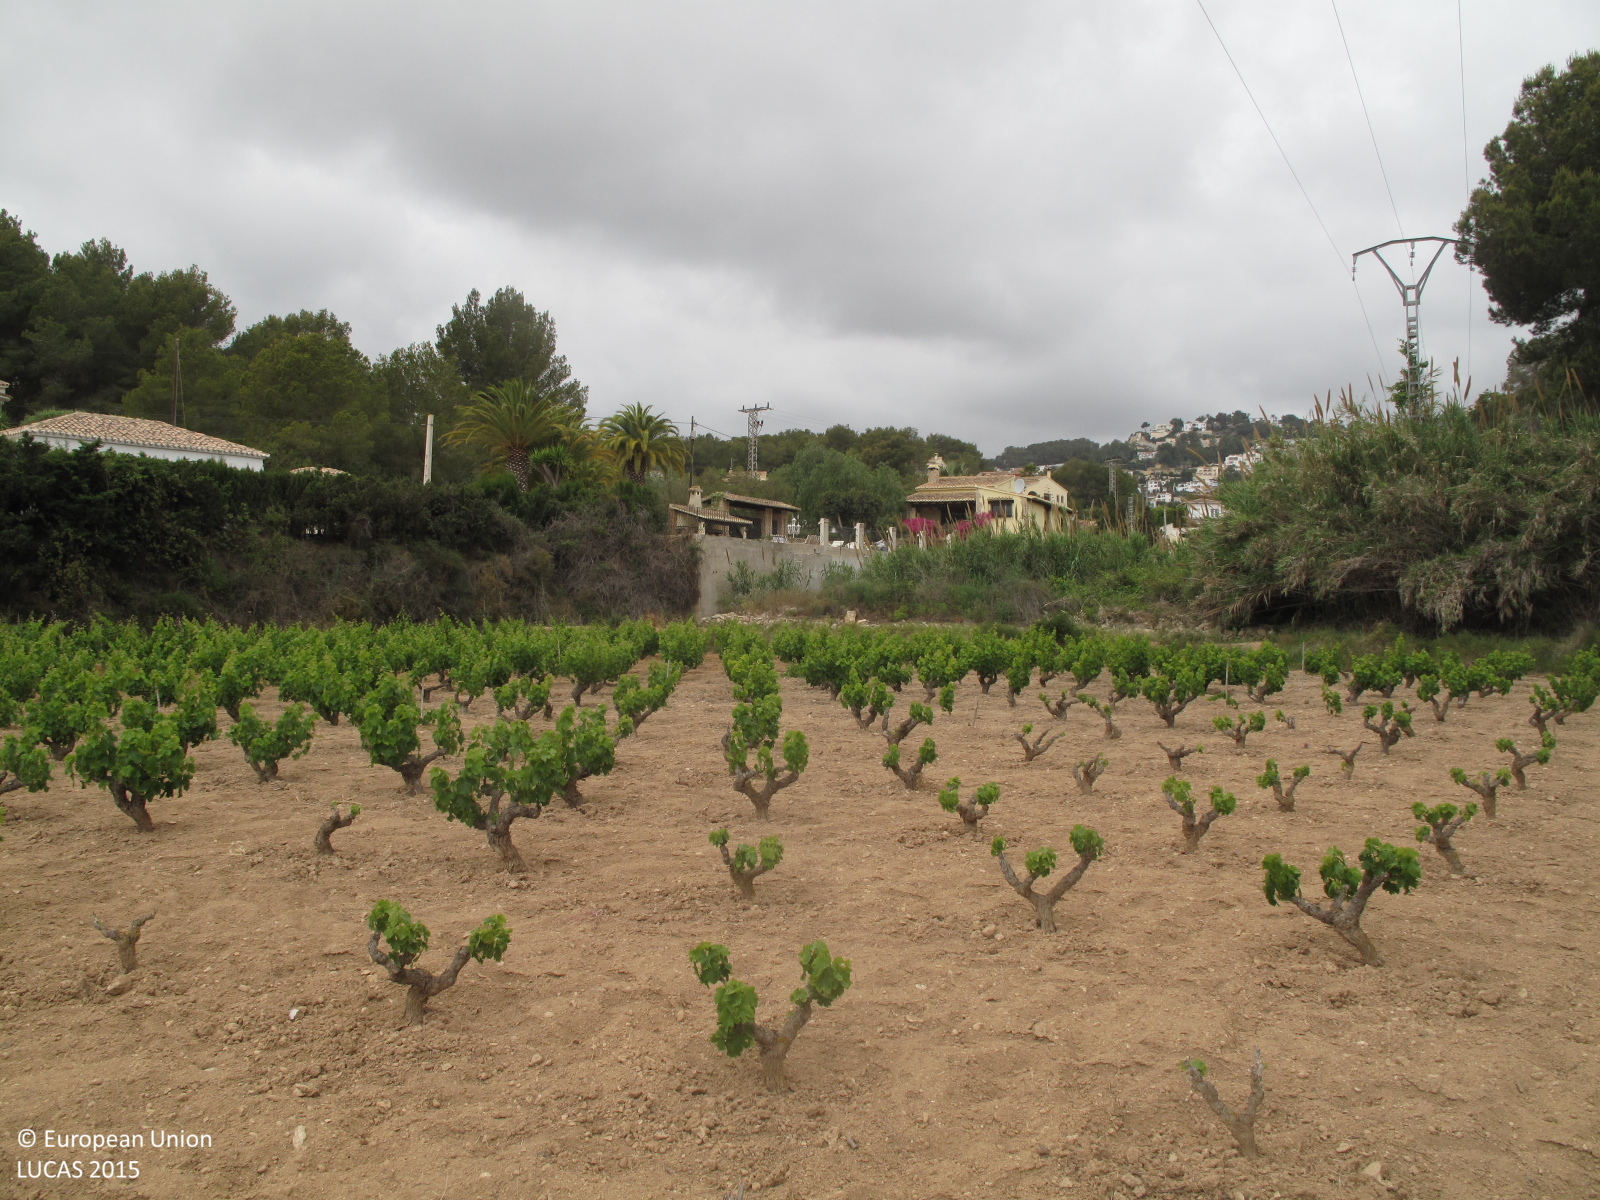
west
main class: Cropland
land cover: Vineyards
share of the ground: 10 - 25 %
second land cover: Other bare soil
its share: > 75 %
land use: Agriculture (excluding fallow land and kitchen gardens)
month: May
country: ES
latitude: 38.6913
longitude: 0.1139
